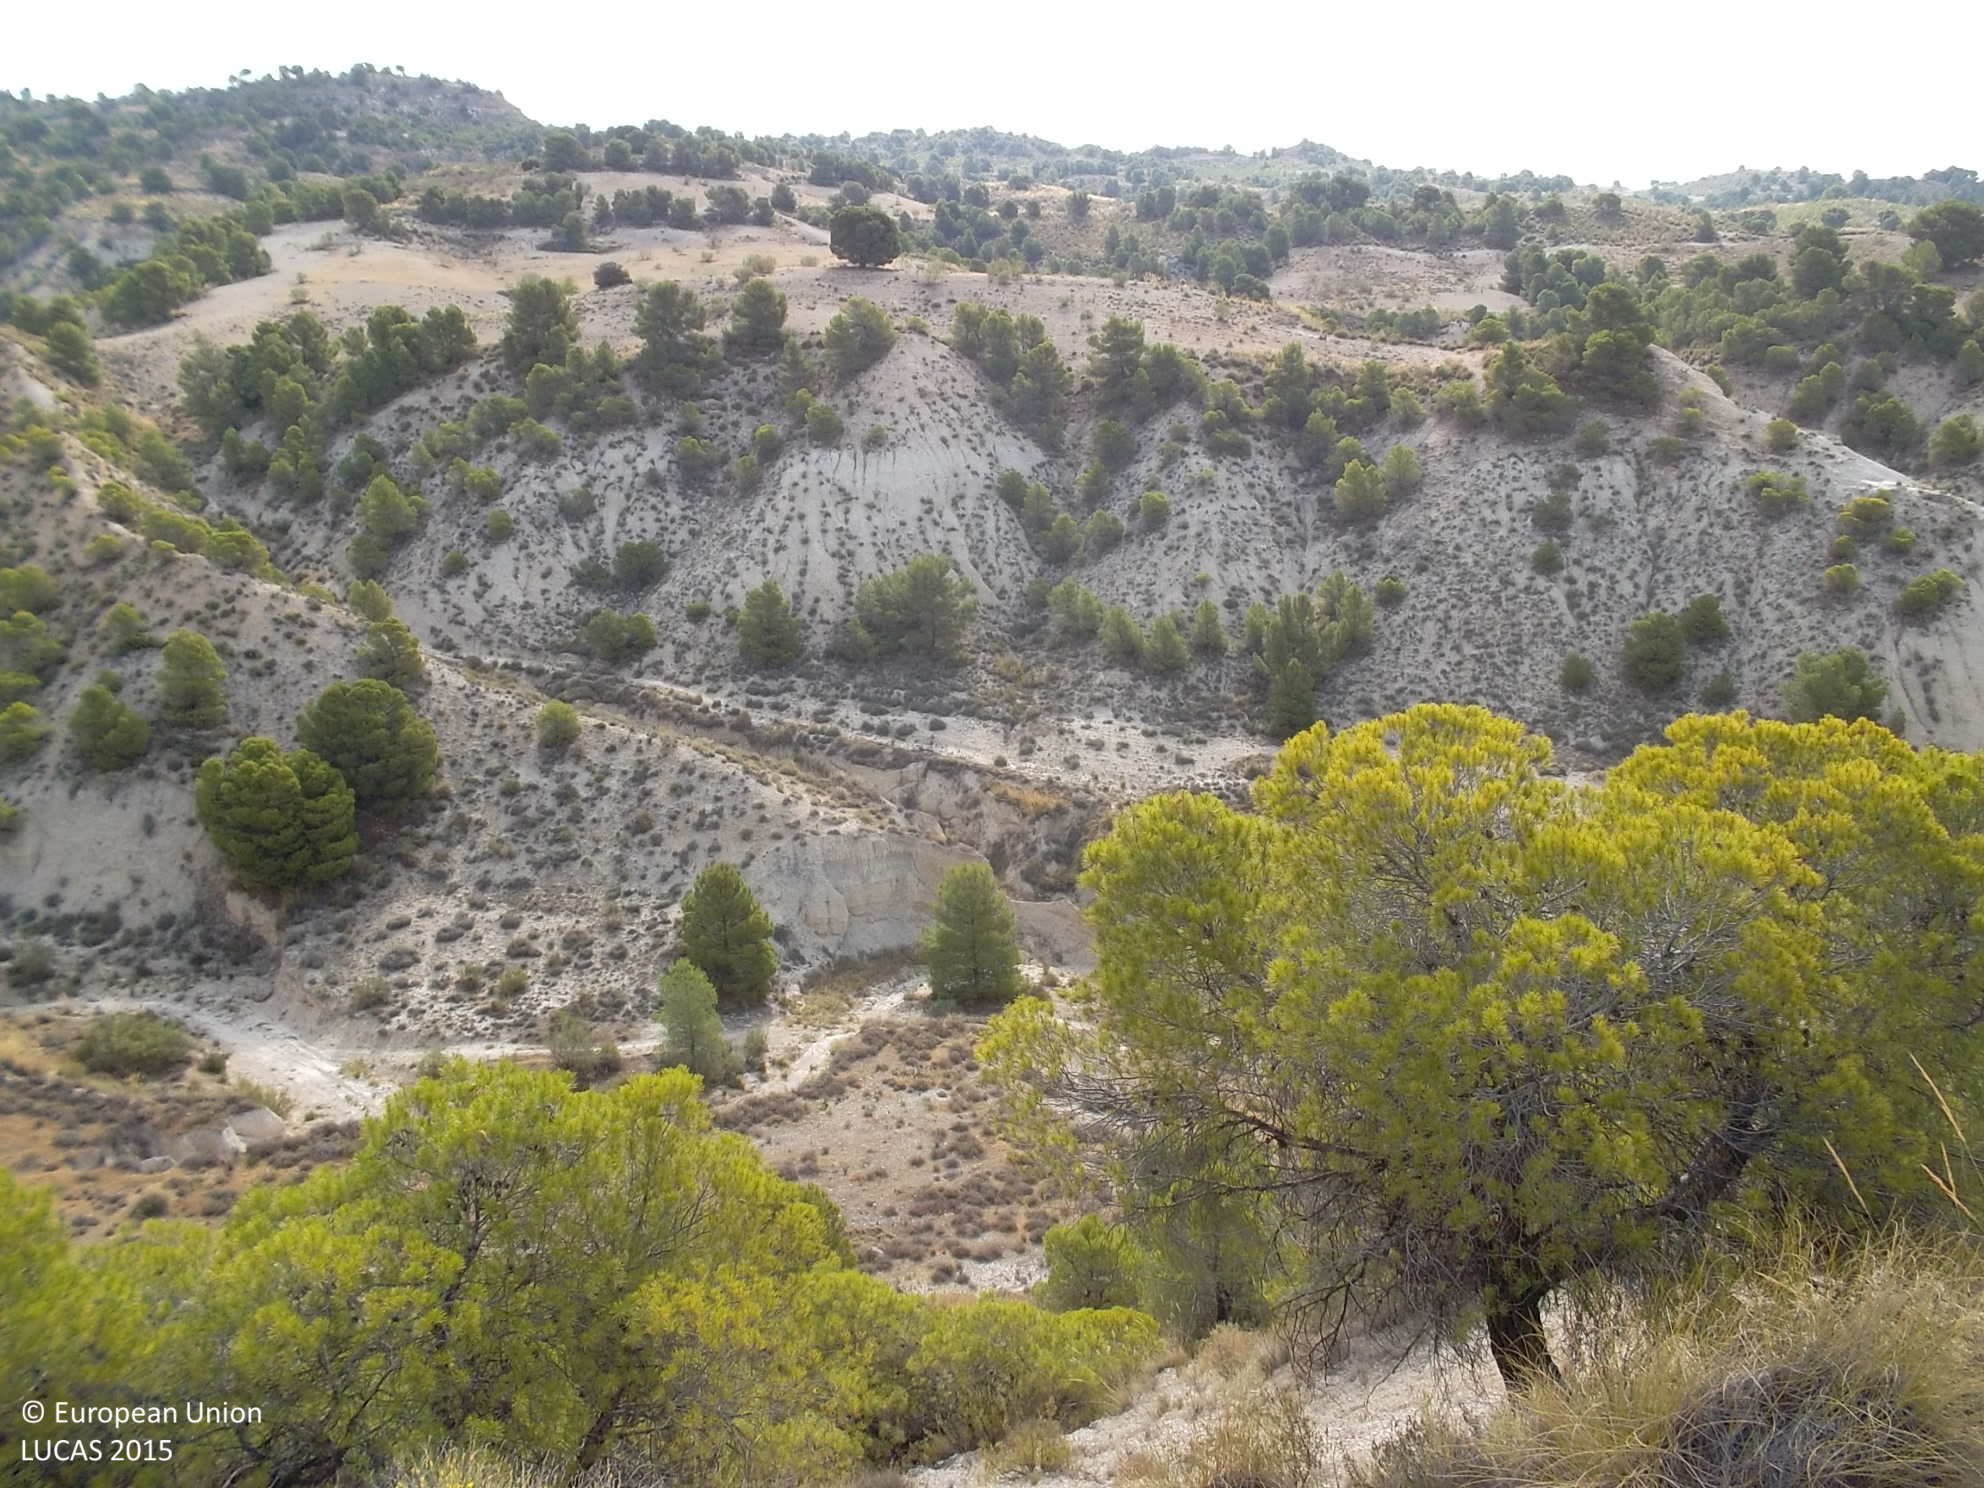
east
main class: Grassland
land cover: Grassland with sparse tree/shrub cover
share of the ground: > 75 %
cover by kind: herbaceous plants 90 %, coniferous forest trees 5 %, shrubs 5 %
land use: Semi-natural and natural areas not in use
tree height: > 5 m
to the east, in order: Grassland with sparse tree/shrub cover; Shrubland with sparse tree cover
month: July
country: ES
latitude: 37.6894
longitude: -2.7704
